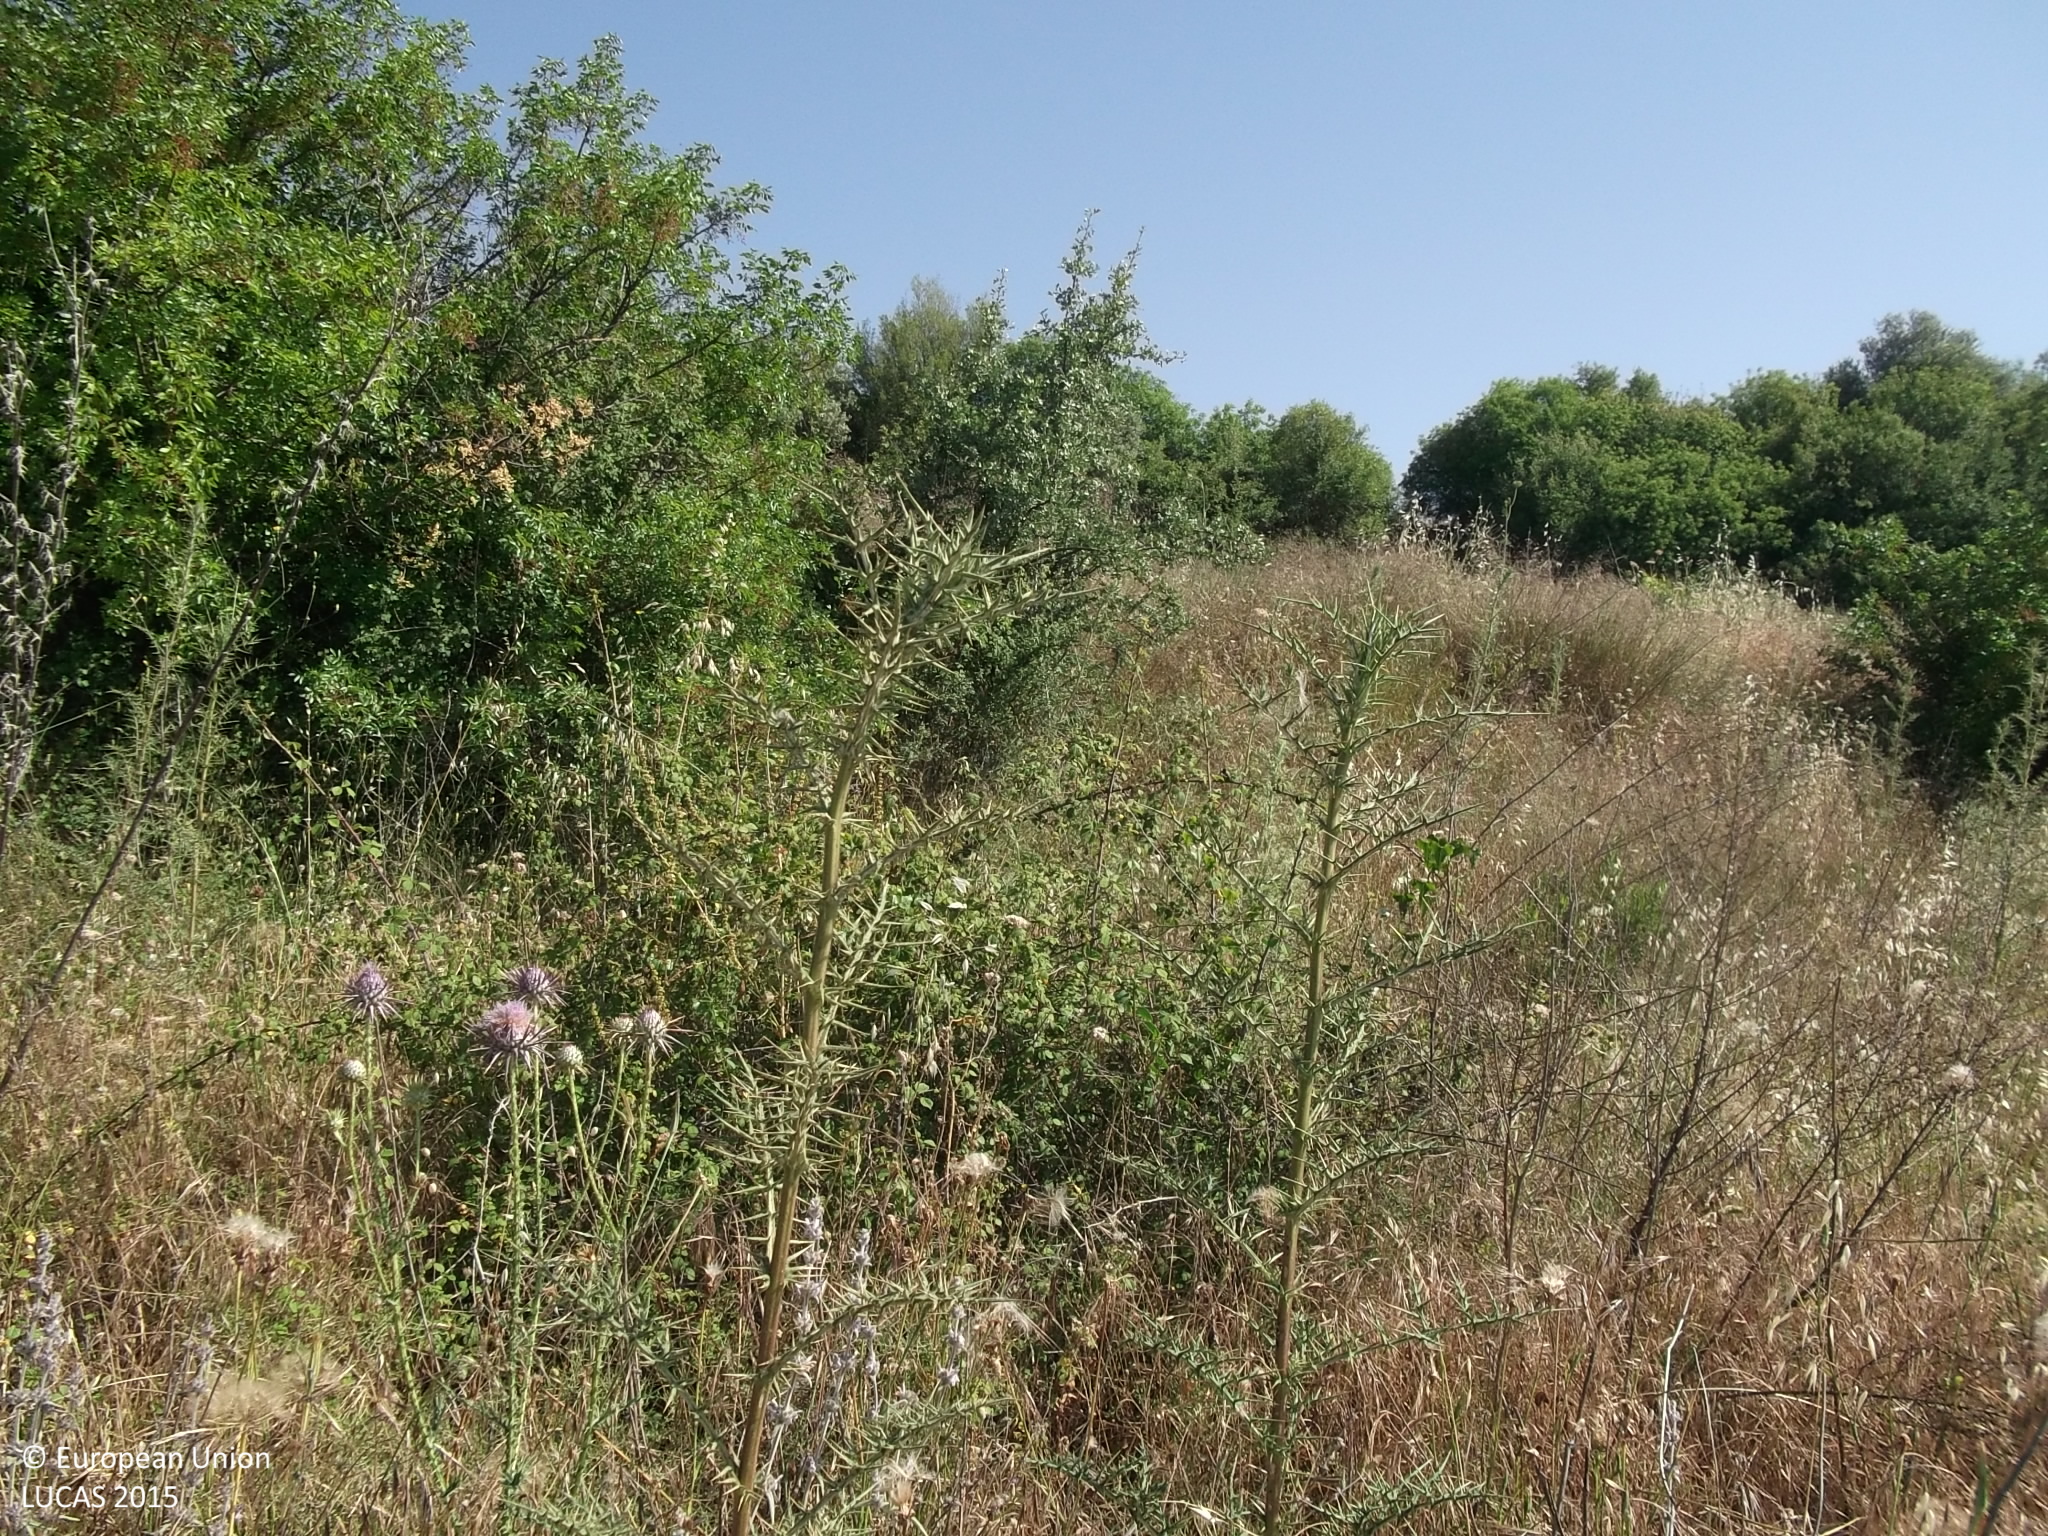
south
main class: Grassland
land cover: Grassland with sparse tree/shrub cover
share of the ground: > 75 %
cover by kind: herbaceous plants 90 %, broadleaved forest trees 5 %, shrubs 5 %
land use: Semi-natural and natural areas not in use
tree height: < 5 m
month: May
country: CY
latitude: 34.8835
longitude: 32.5724
